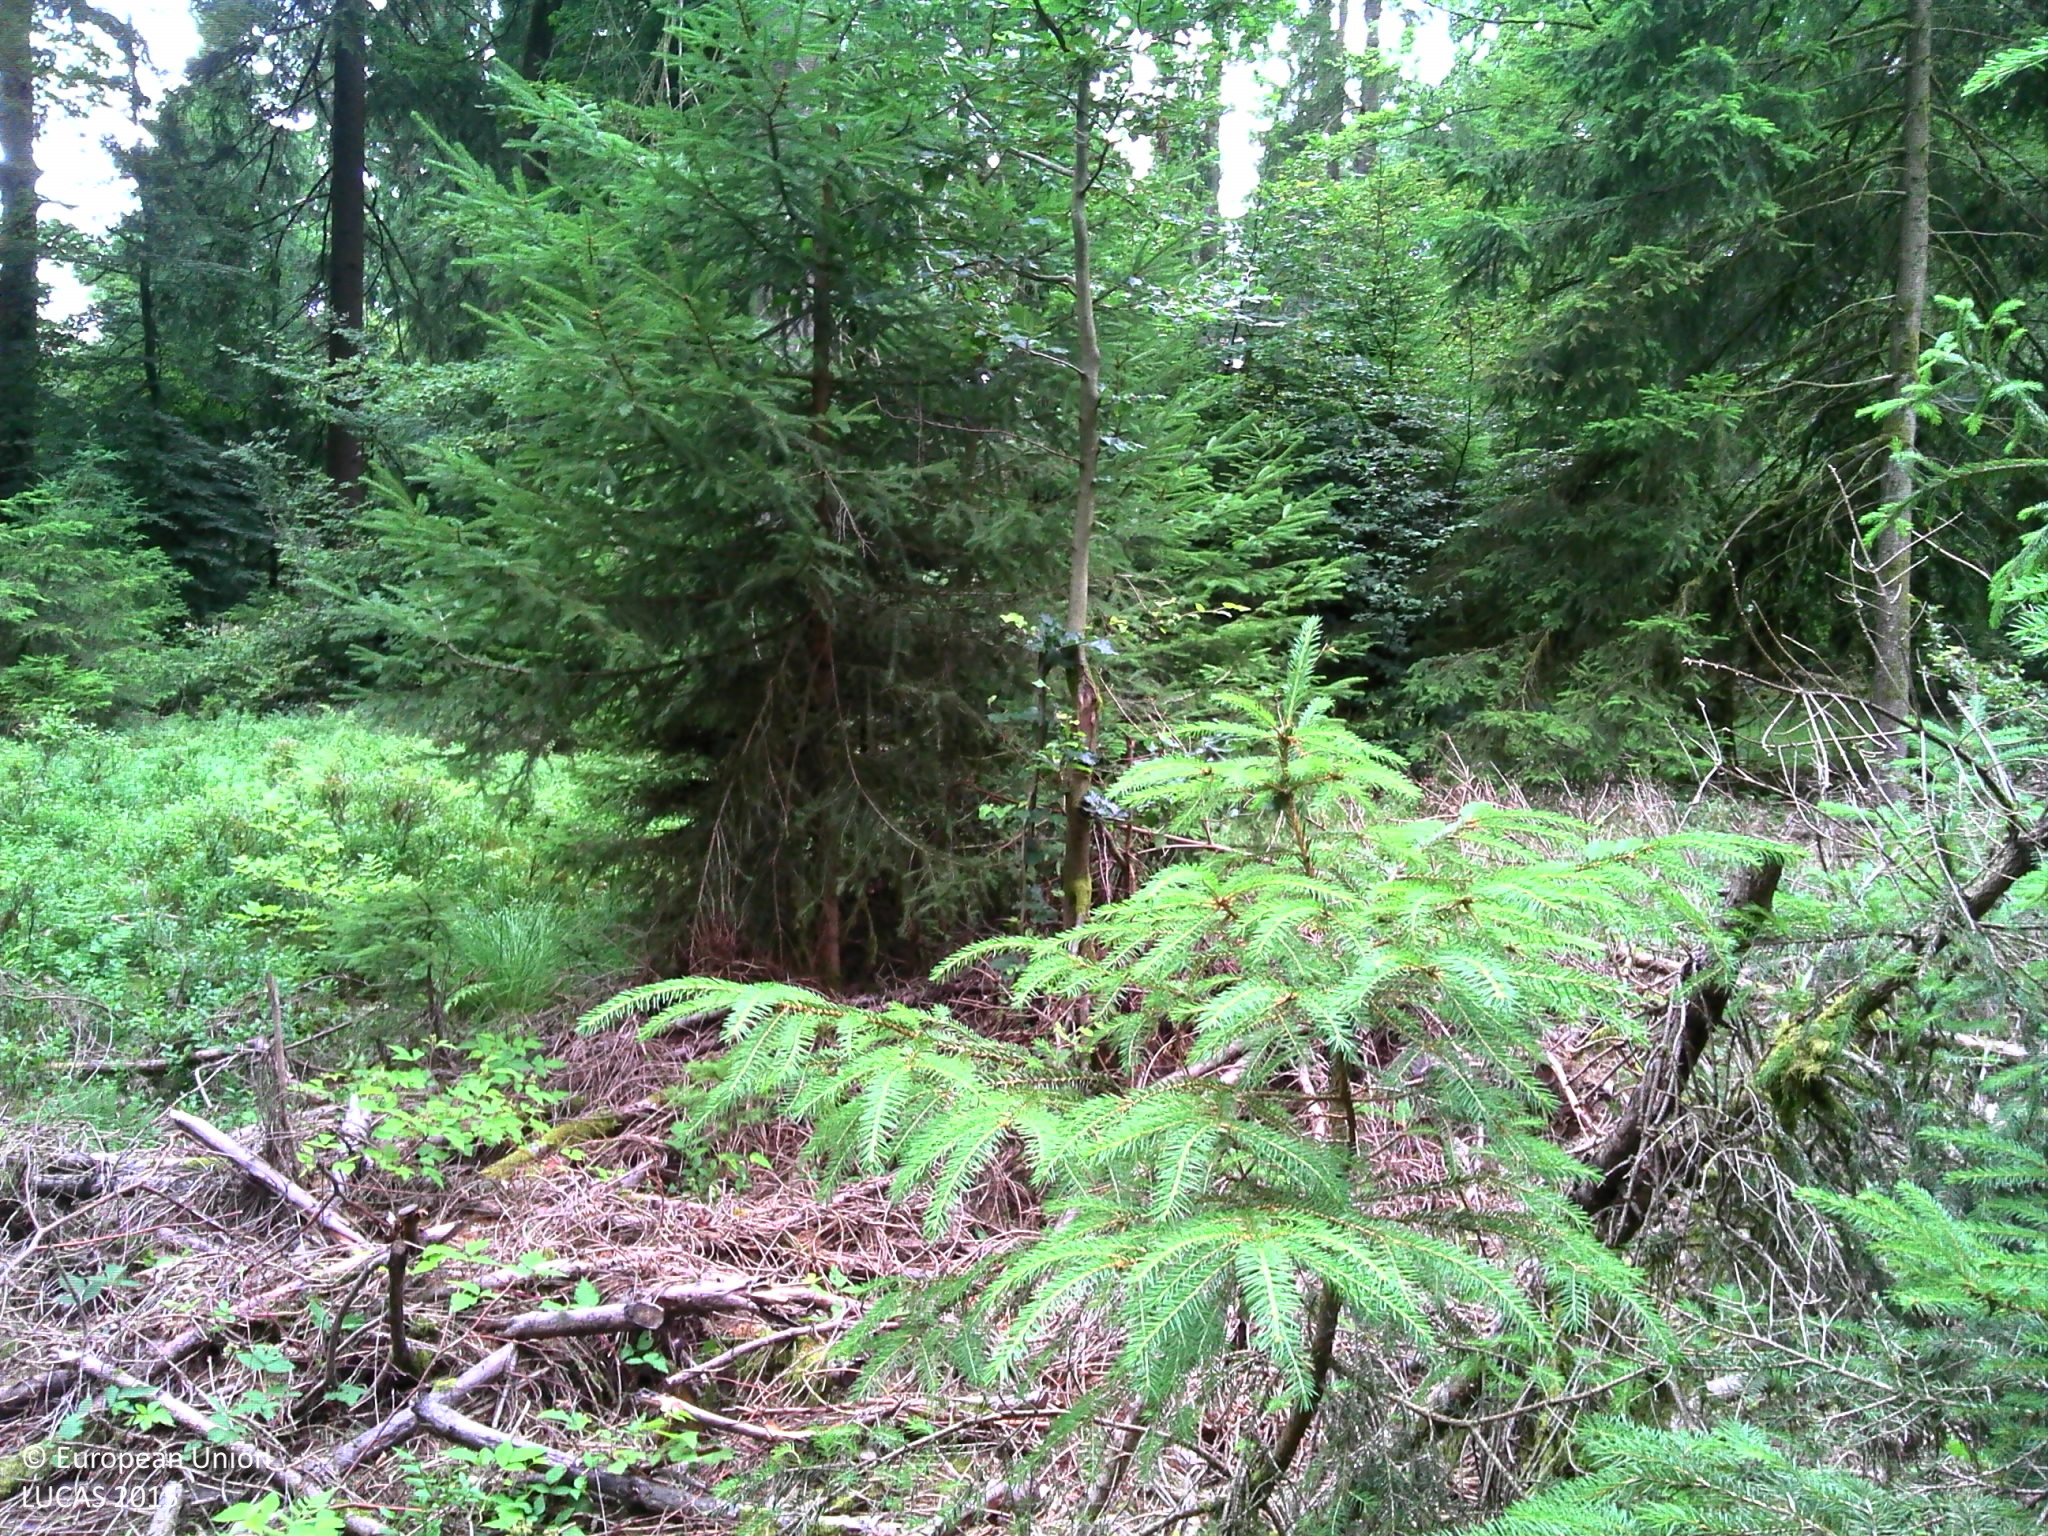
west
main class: Woodland
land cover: Spruce dominated coniferous woodland
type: hemiboreal forest and nemoral coniferous forest and mixed broadleaved-coniferous forest
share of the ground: 50 - 75 %
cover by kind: coniferous forest trees 60 %, herbaceous plants 20 %, shrubs 10 %, unconsolidated bare surface 10 %
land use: Forestry
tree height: > 5 m
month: July
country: BE
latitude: 49.7571
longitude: 5.5983
